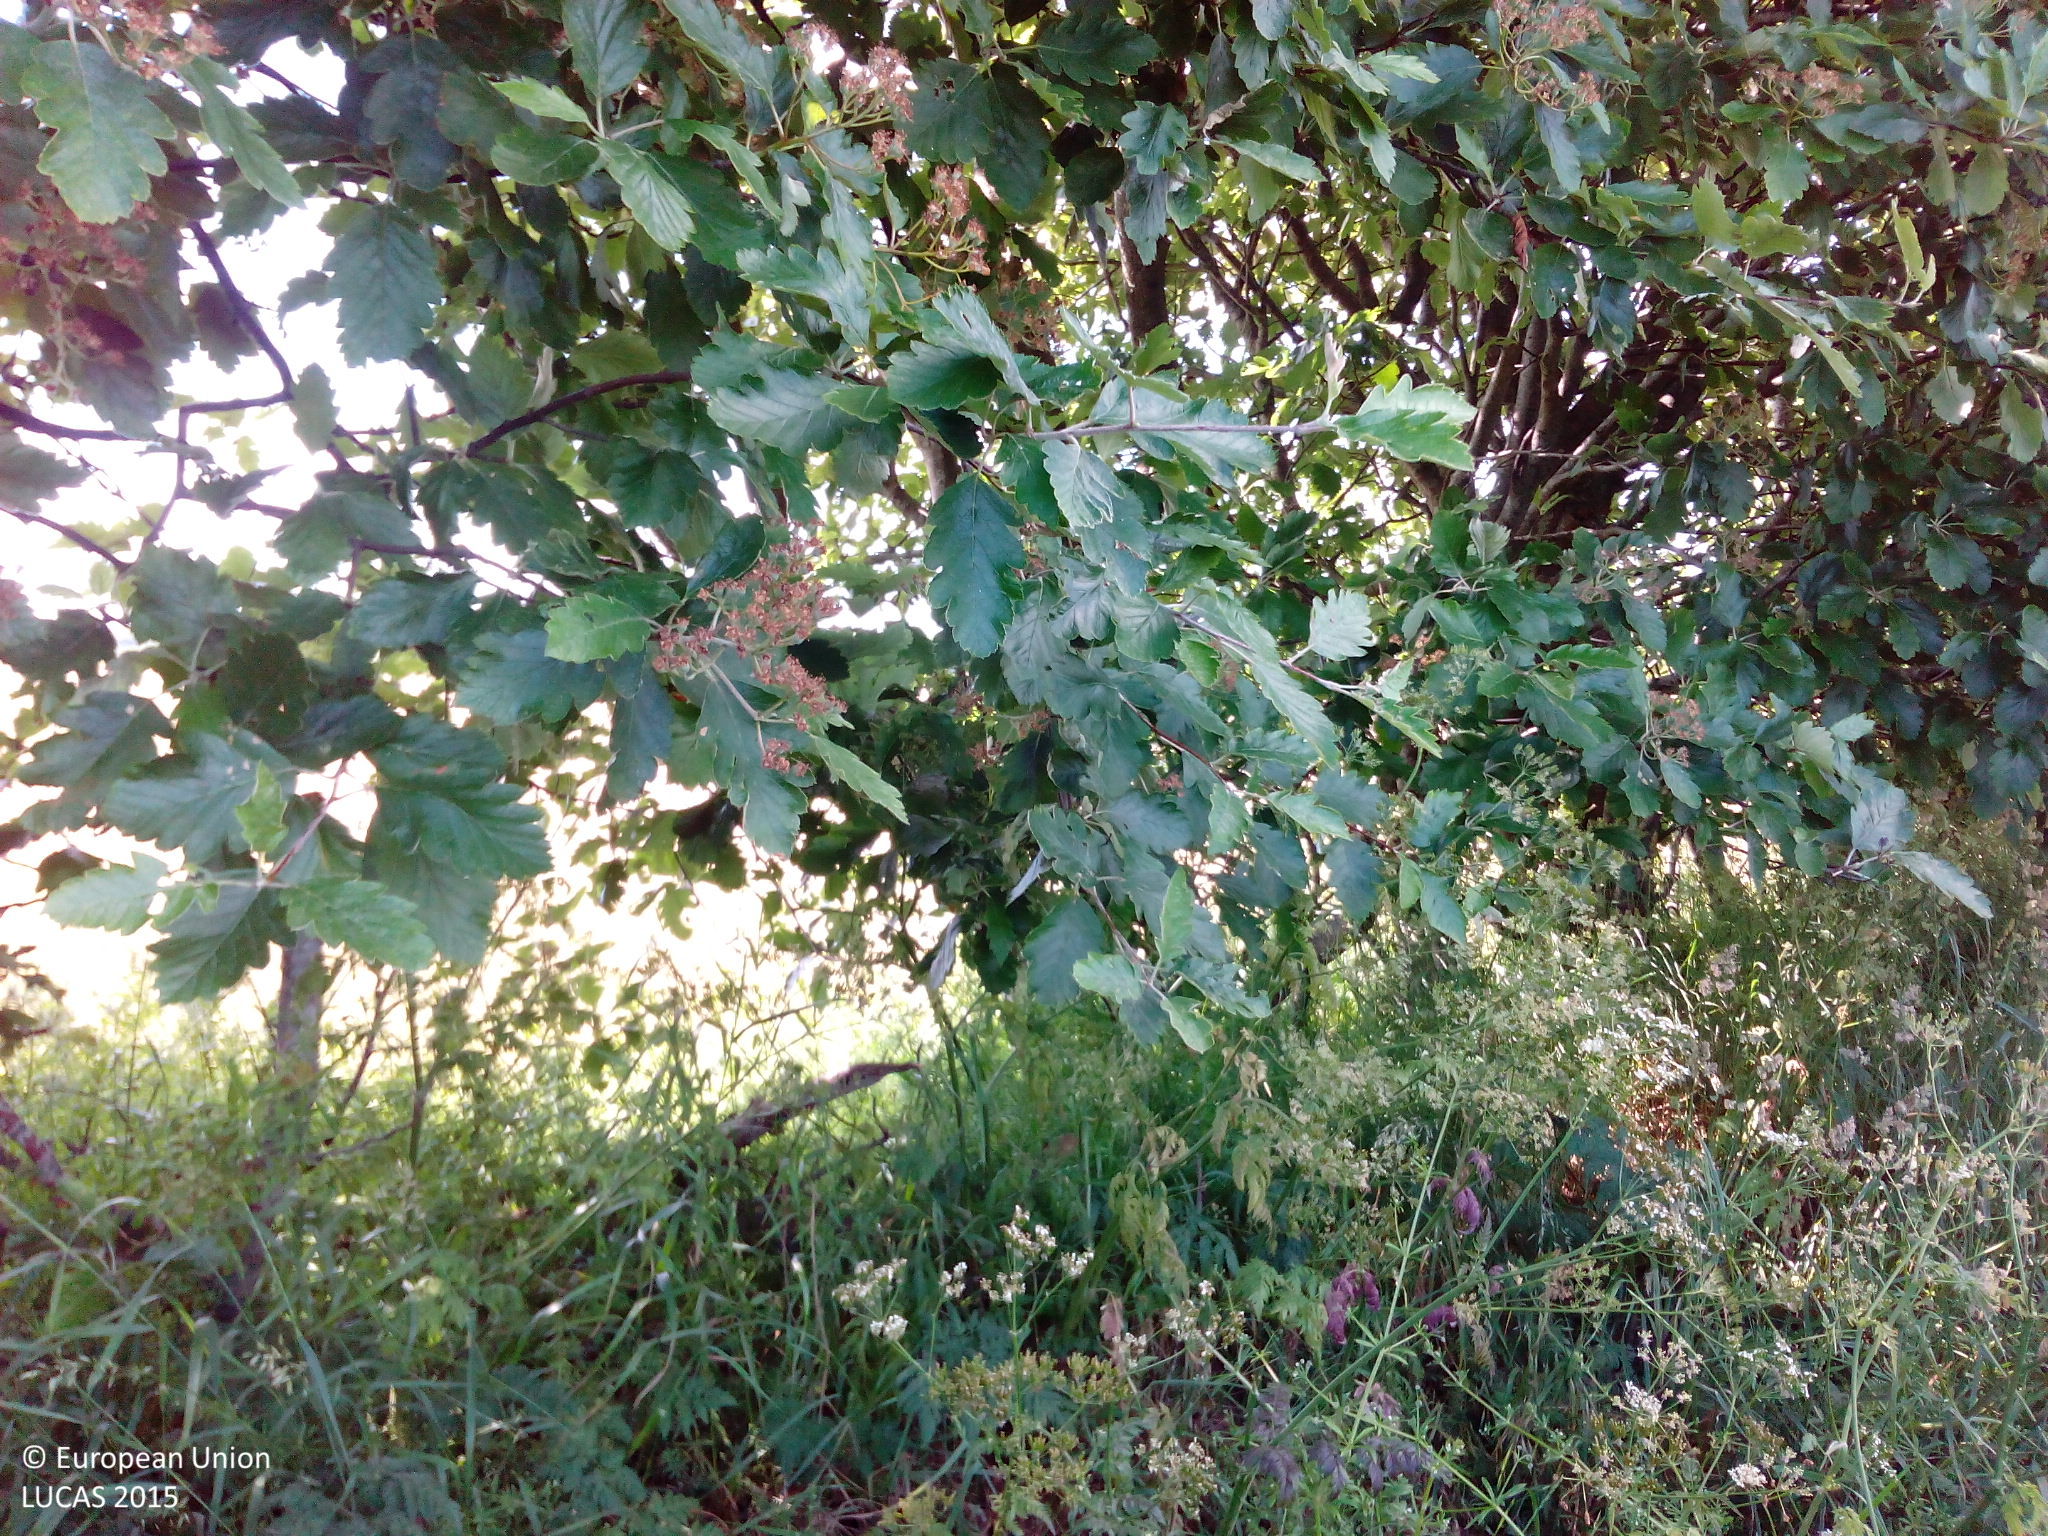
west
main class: Cropland
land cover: Rape and turnip rape
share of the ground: > 75 %
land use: Agriculture (excluding fallow land and kitchen gardens)
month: June
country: DK
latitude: 56.3109
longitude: 10.8234
